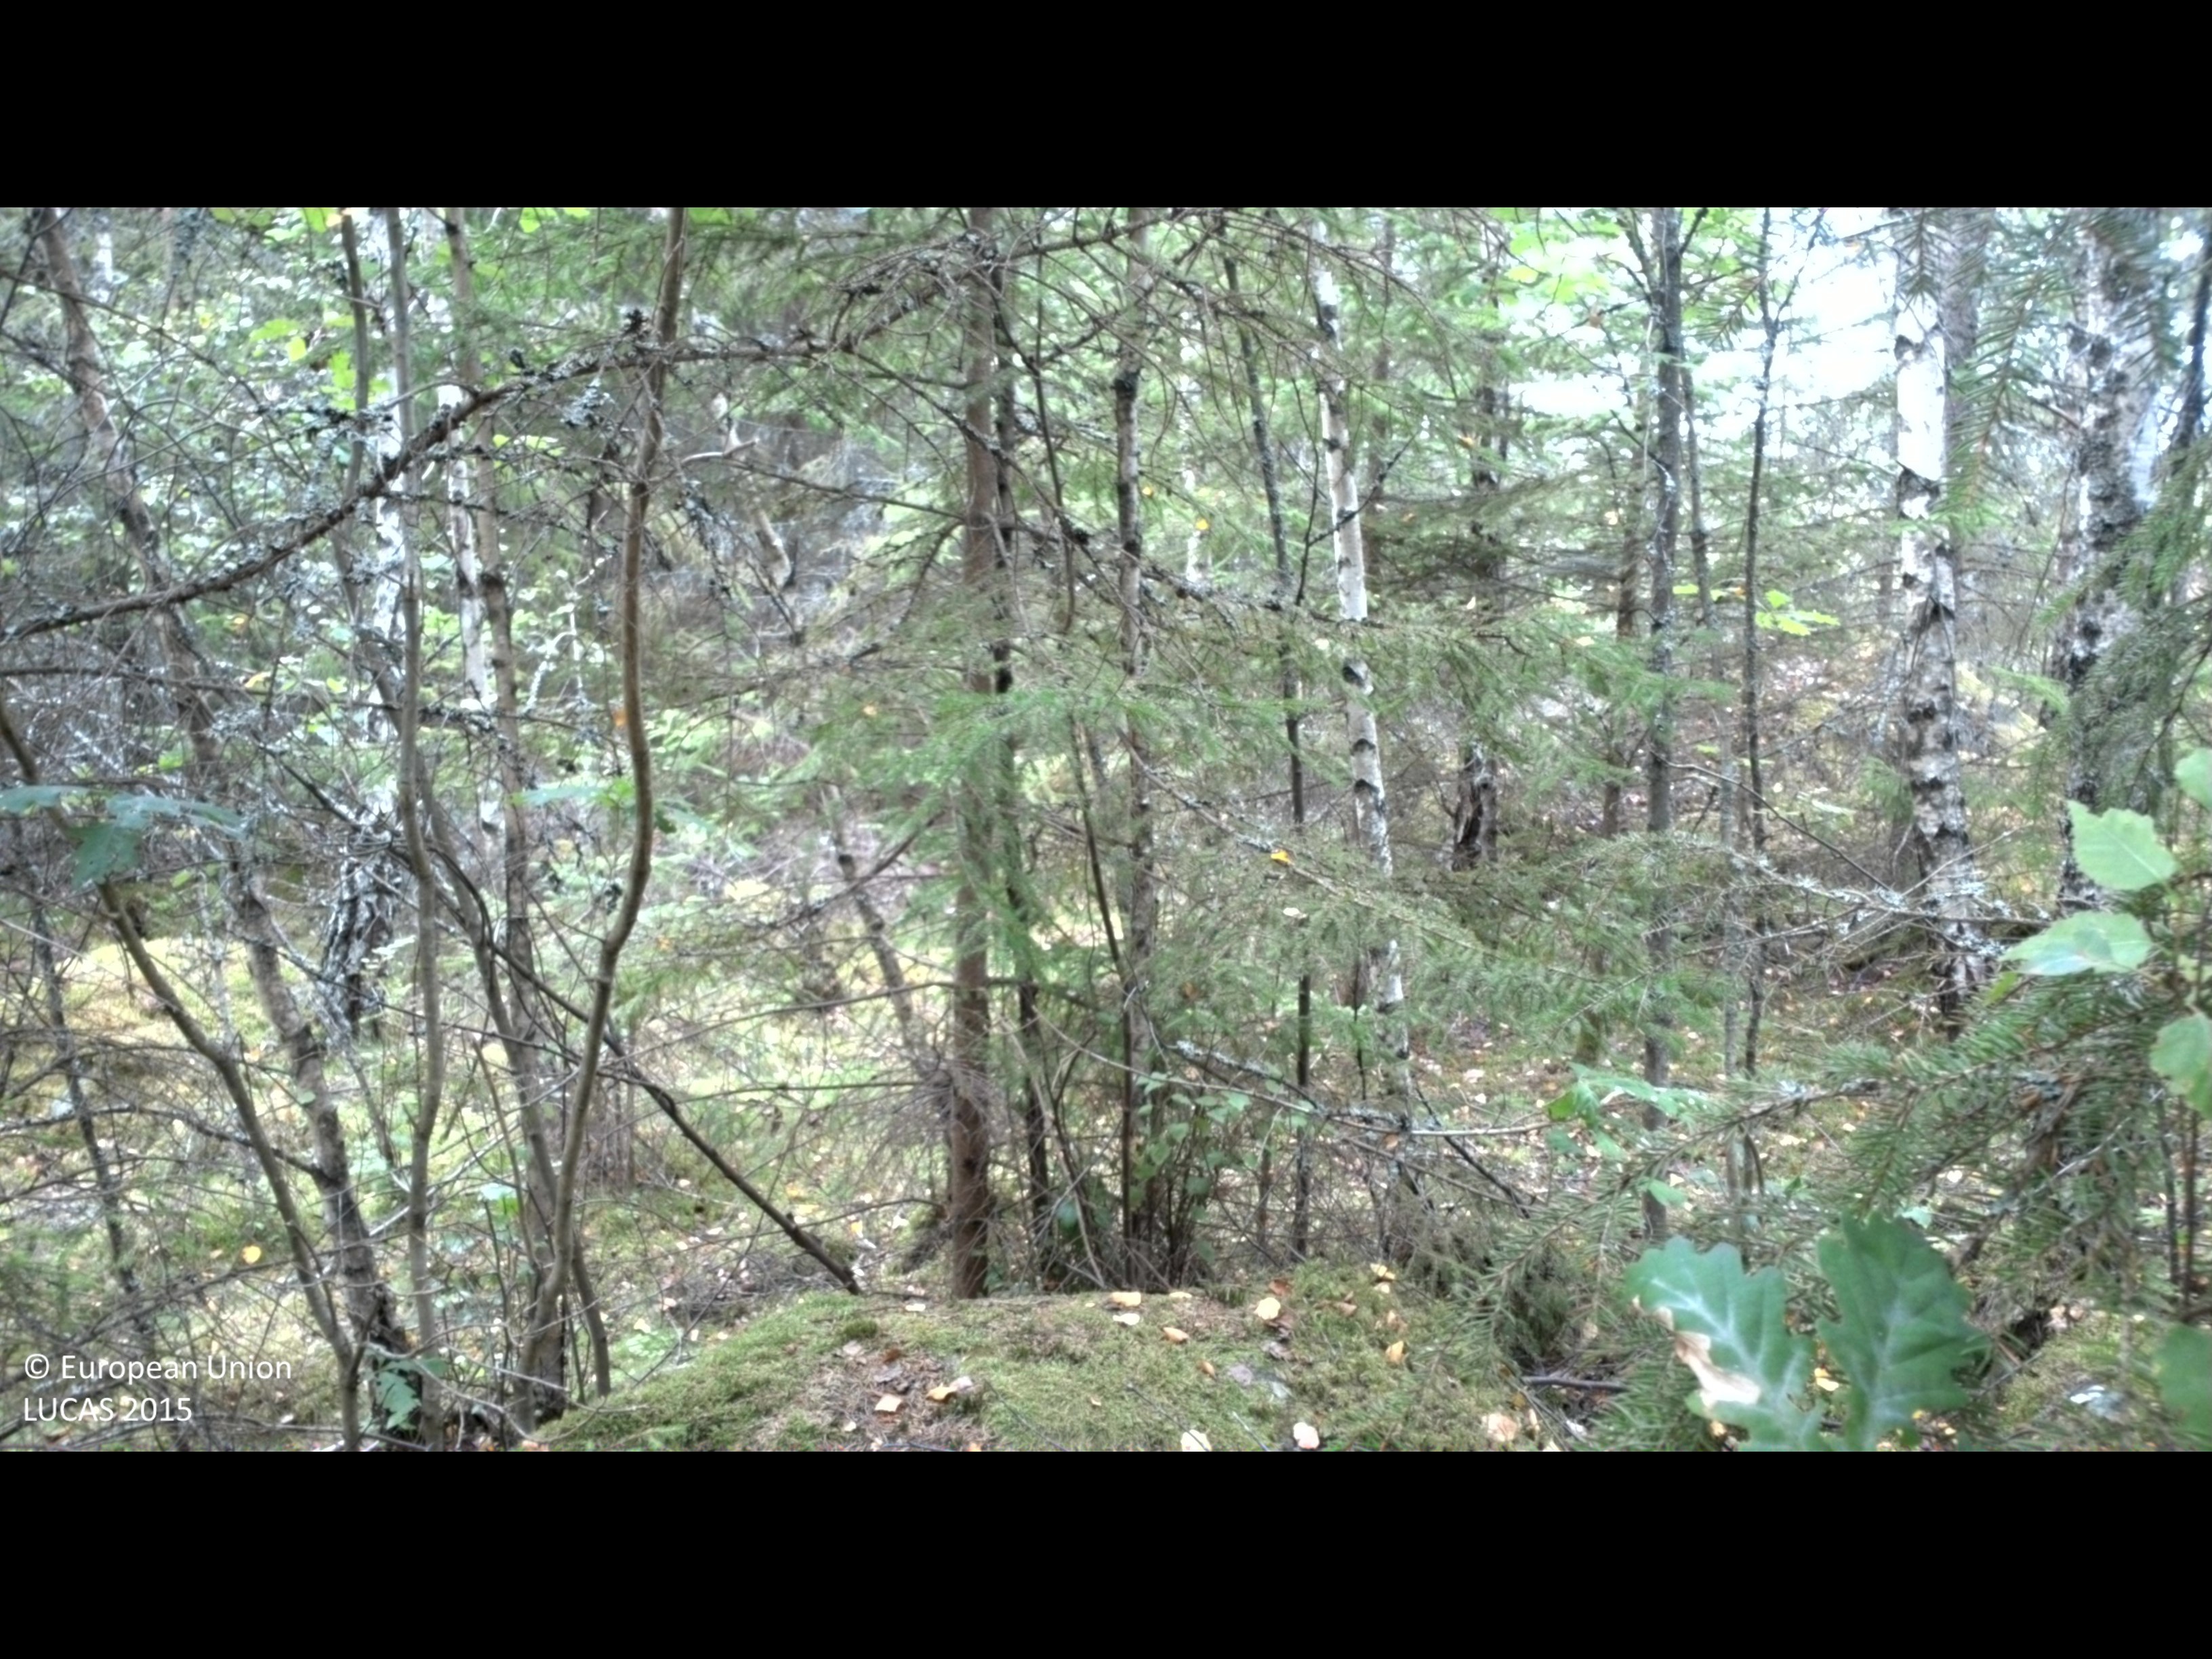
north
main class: Woodland
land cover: Spruce dominated mixed woodland
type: boreal forest
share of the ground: > 75 %
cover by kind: coniferous forest trees 55 %, broadleaved forest trees 25 %, lichens and mosses 20 %
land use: Forestry
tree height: > 5 m
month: August
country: SE
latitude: 56.3235
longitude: 15.0274
